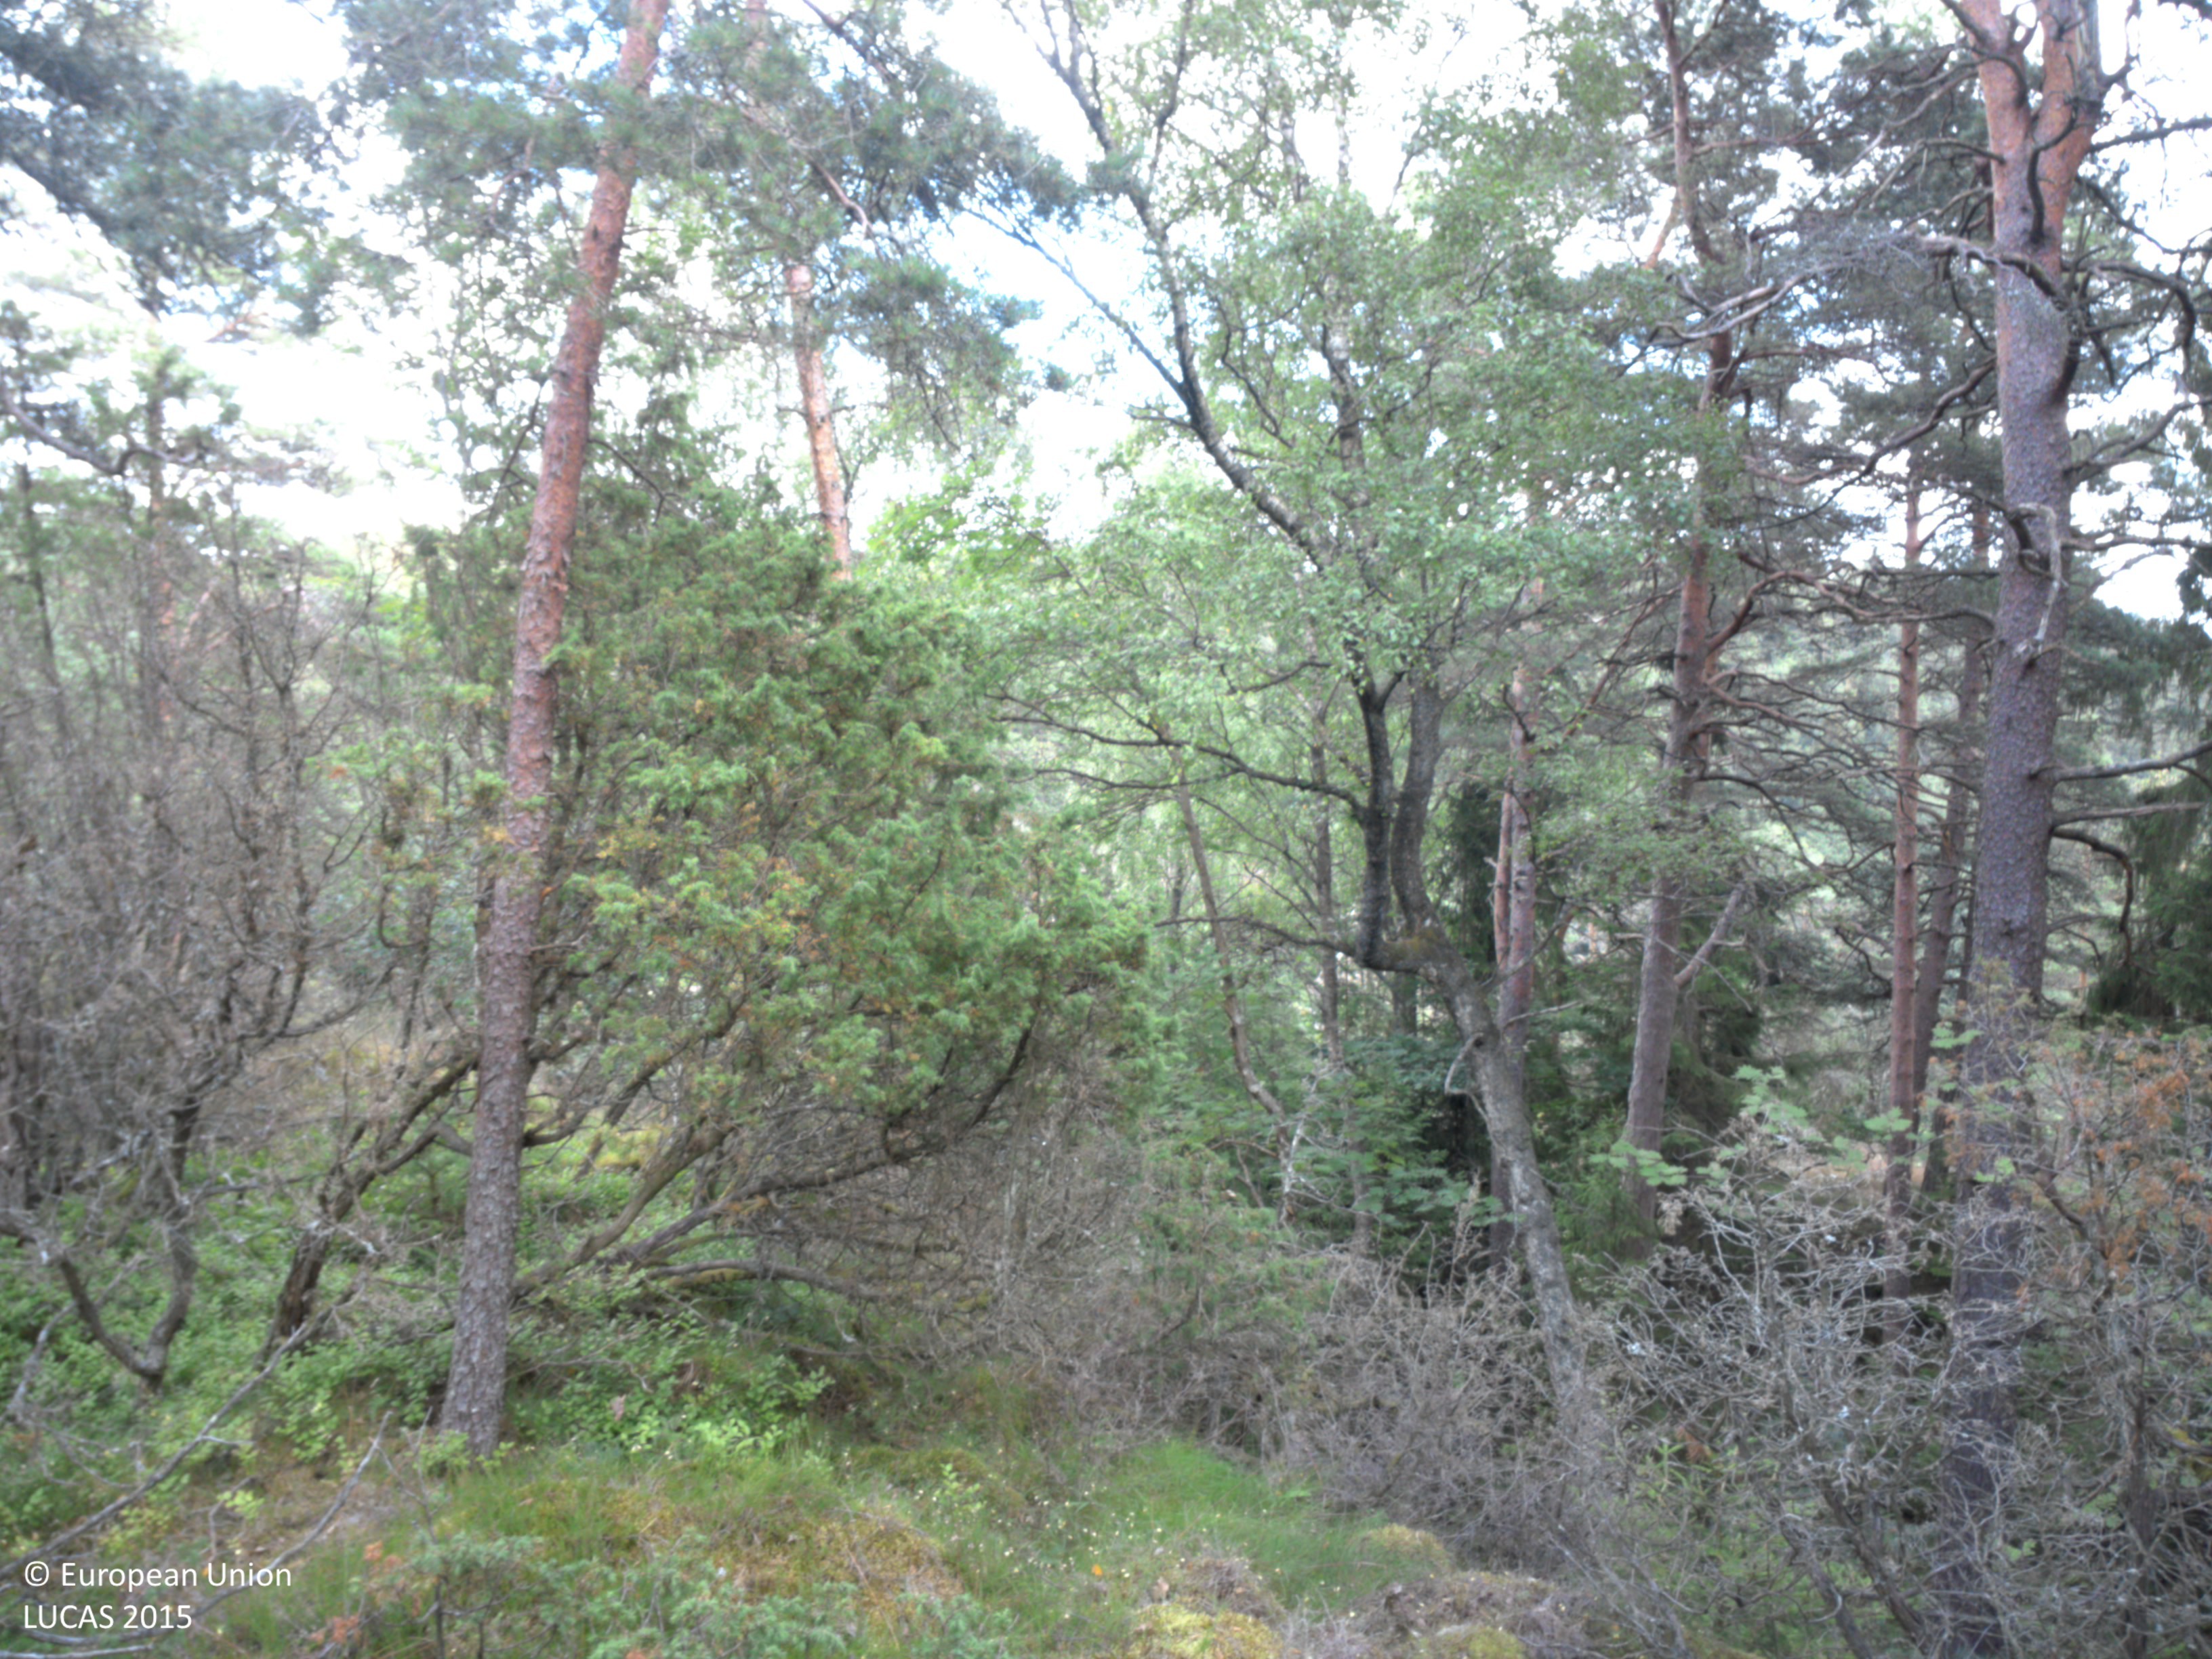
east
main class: Woodland
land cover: Pine dominated coniferous woodland
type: boreal forest
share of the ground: 50 - 75 %
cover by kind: coniferous forest trees 50 %, lichens and mosses 25 %, consolidated bare surface 15 %, herbaceous plants 10 %
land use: Forestry
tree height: > 5 m
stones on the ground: < 10 %
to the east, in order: Pine dominated coniferous woodland; Pine dominated mixed woodland; Spruce dominated mixed woodland; Paved roads, cycling and walking lanes; Grass margins; Electric lines; Grass margins; Paved roads, cycling and walking lanes; Grass margins; Ditches and canals; Managed hedges; Single bushes/trees; Grassland with sparse tree/shrub cover; Other mixed woodland; Tracks; Other mixed woodland; Other coniferous woodland
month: July
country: SE
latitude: 58.2090
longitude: 11.6815
